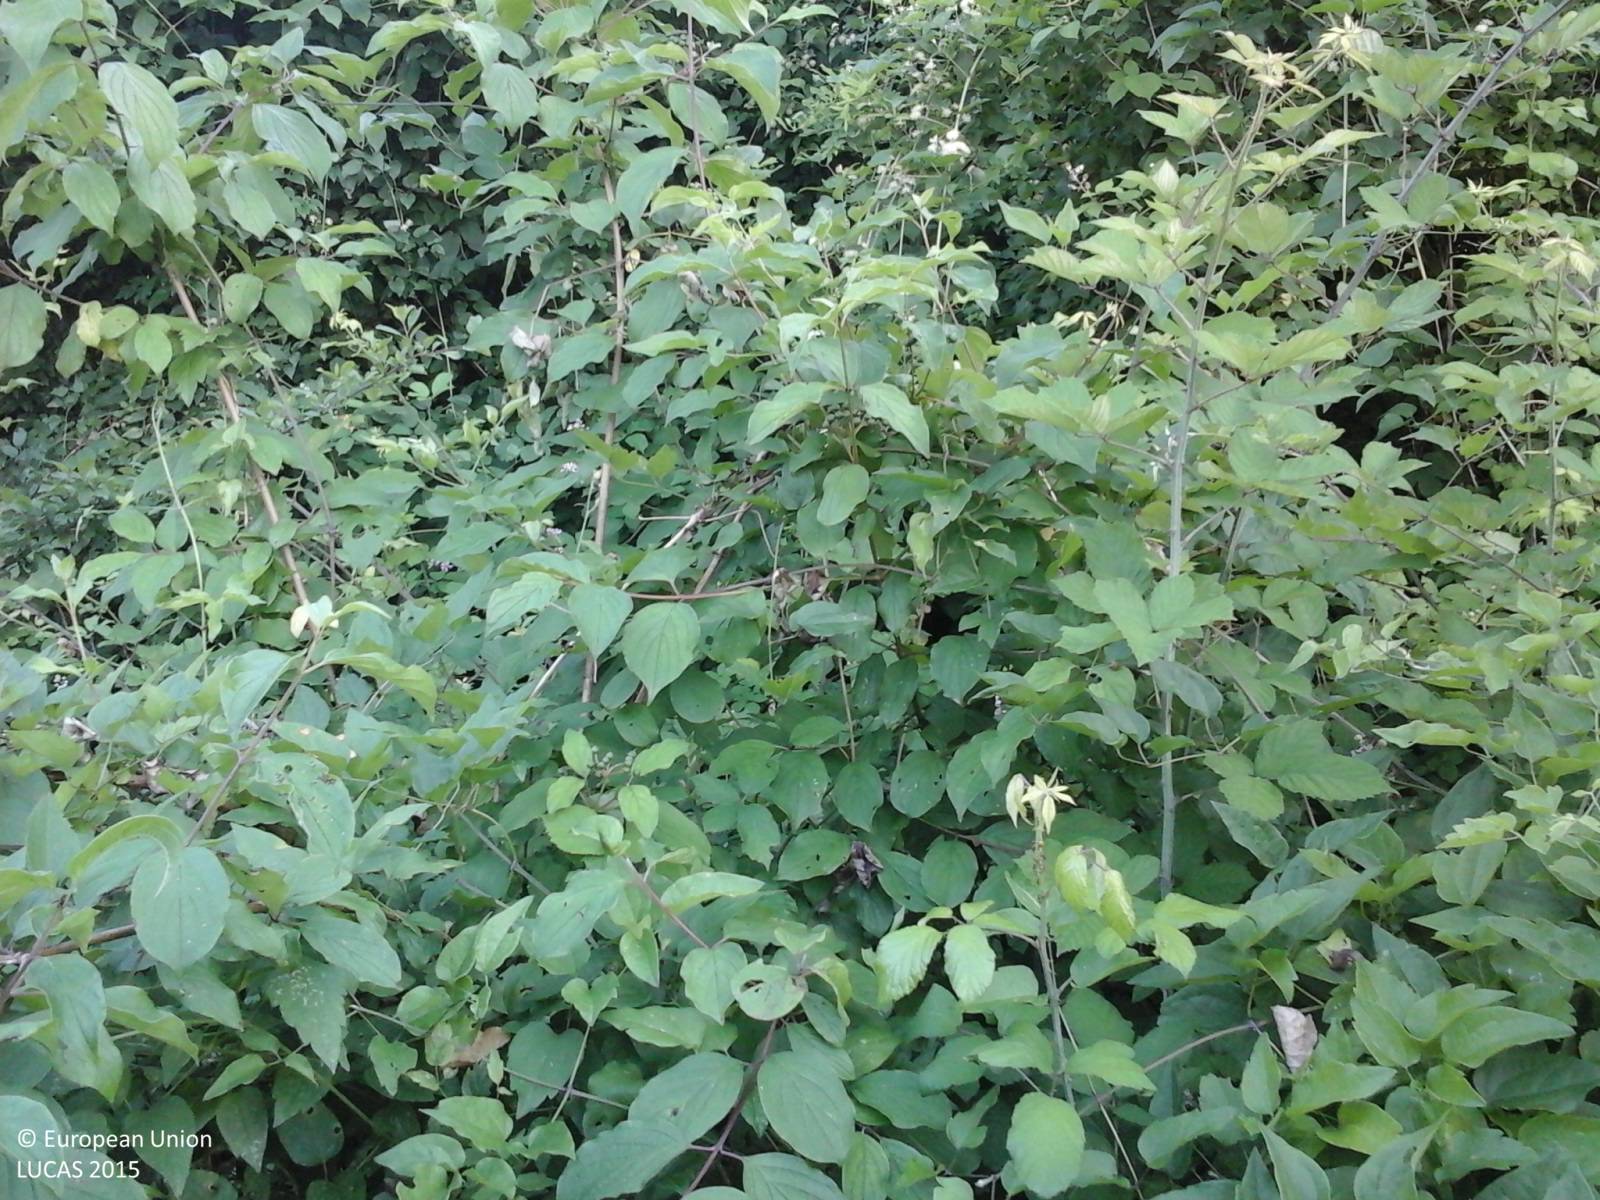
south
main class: Woodland
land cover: Broadleaved woodland
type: floodplain forest
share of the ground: > 75 %
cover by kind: broadleaved forest trees 65 %, shrubs 25 %, herbaceous plants 10 %
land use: Forestry
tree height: > 5 m
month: June
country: IT
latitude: 45.8828
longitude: 12.7668
